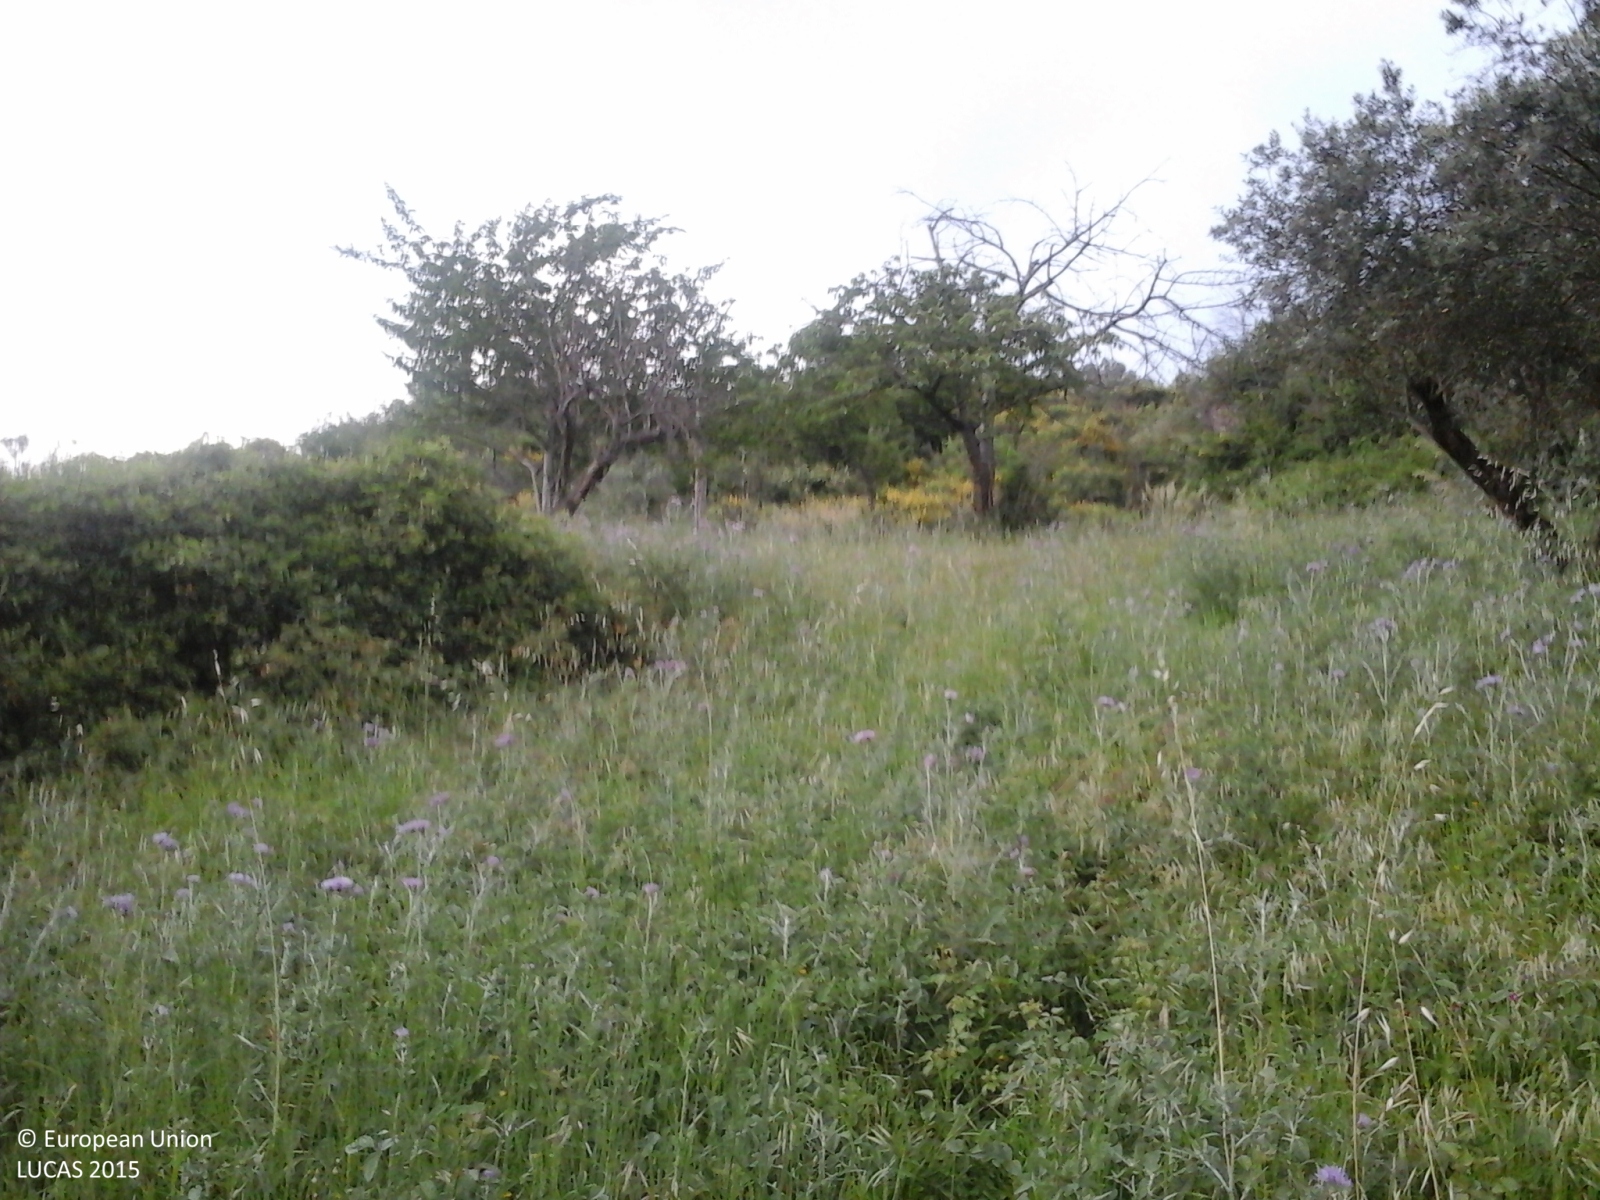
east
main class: Woodland
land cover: Broadleaved woodland
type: thermophilous deciduous forest
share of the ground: > 75 %
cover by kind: broadleaved forest trees 100 %
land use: Abandoned areas
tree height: > 5 m
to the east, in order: Broadleaved woodland; Olive groves; Ditches and canals; Broadleaved woodland; Olive groves; Spontaneously vegetated surfaces; Shrubland with sparse tree cover; Paved roads, cycling and walking lanes; Abandoned hedges; Other bare soil; Olive groves
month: May
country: IT
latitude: 41.2273
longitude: 14.6232
